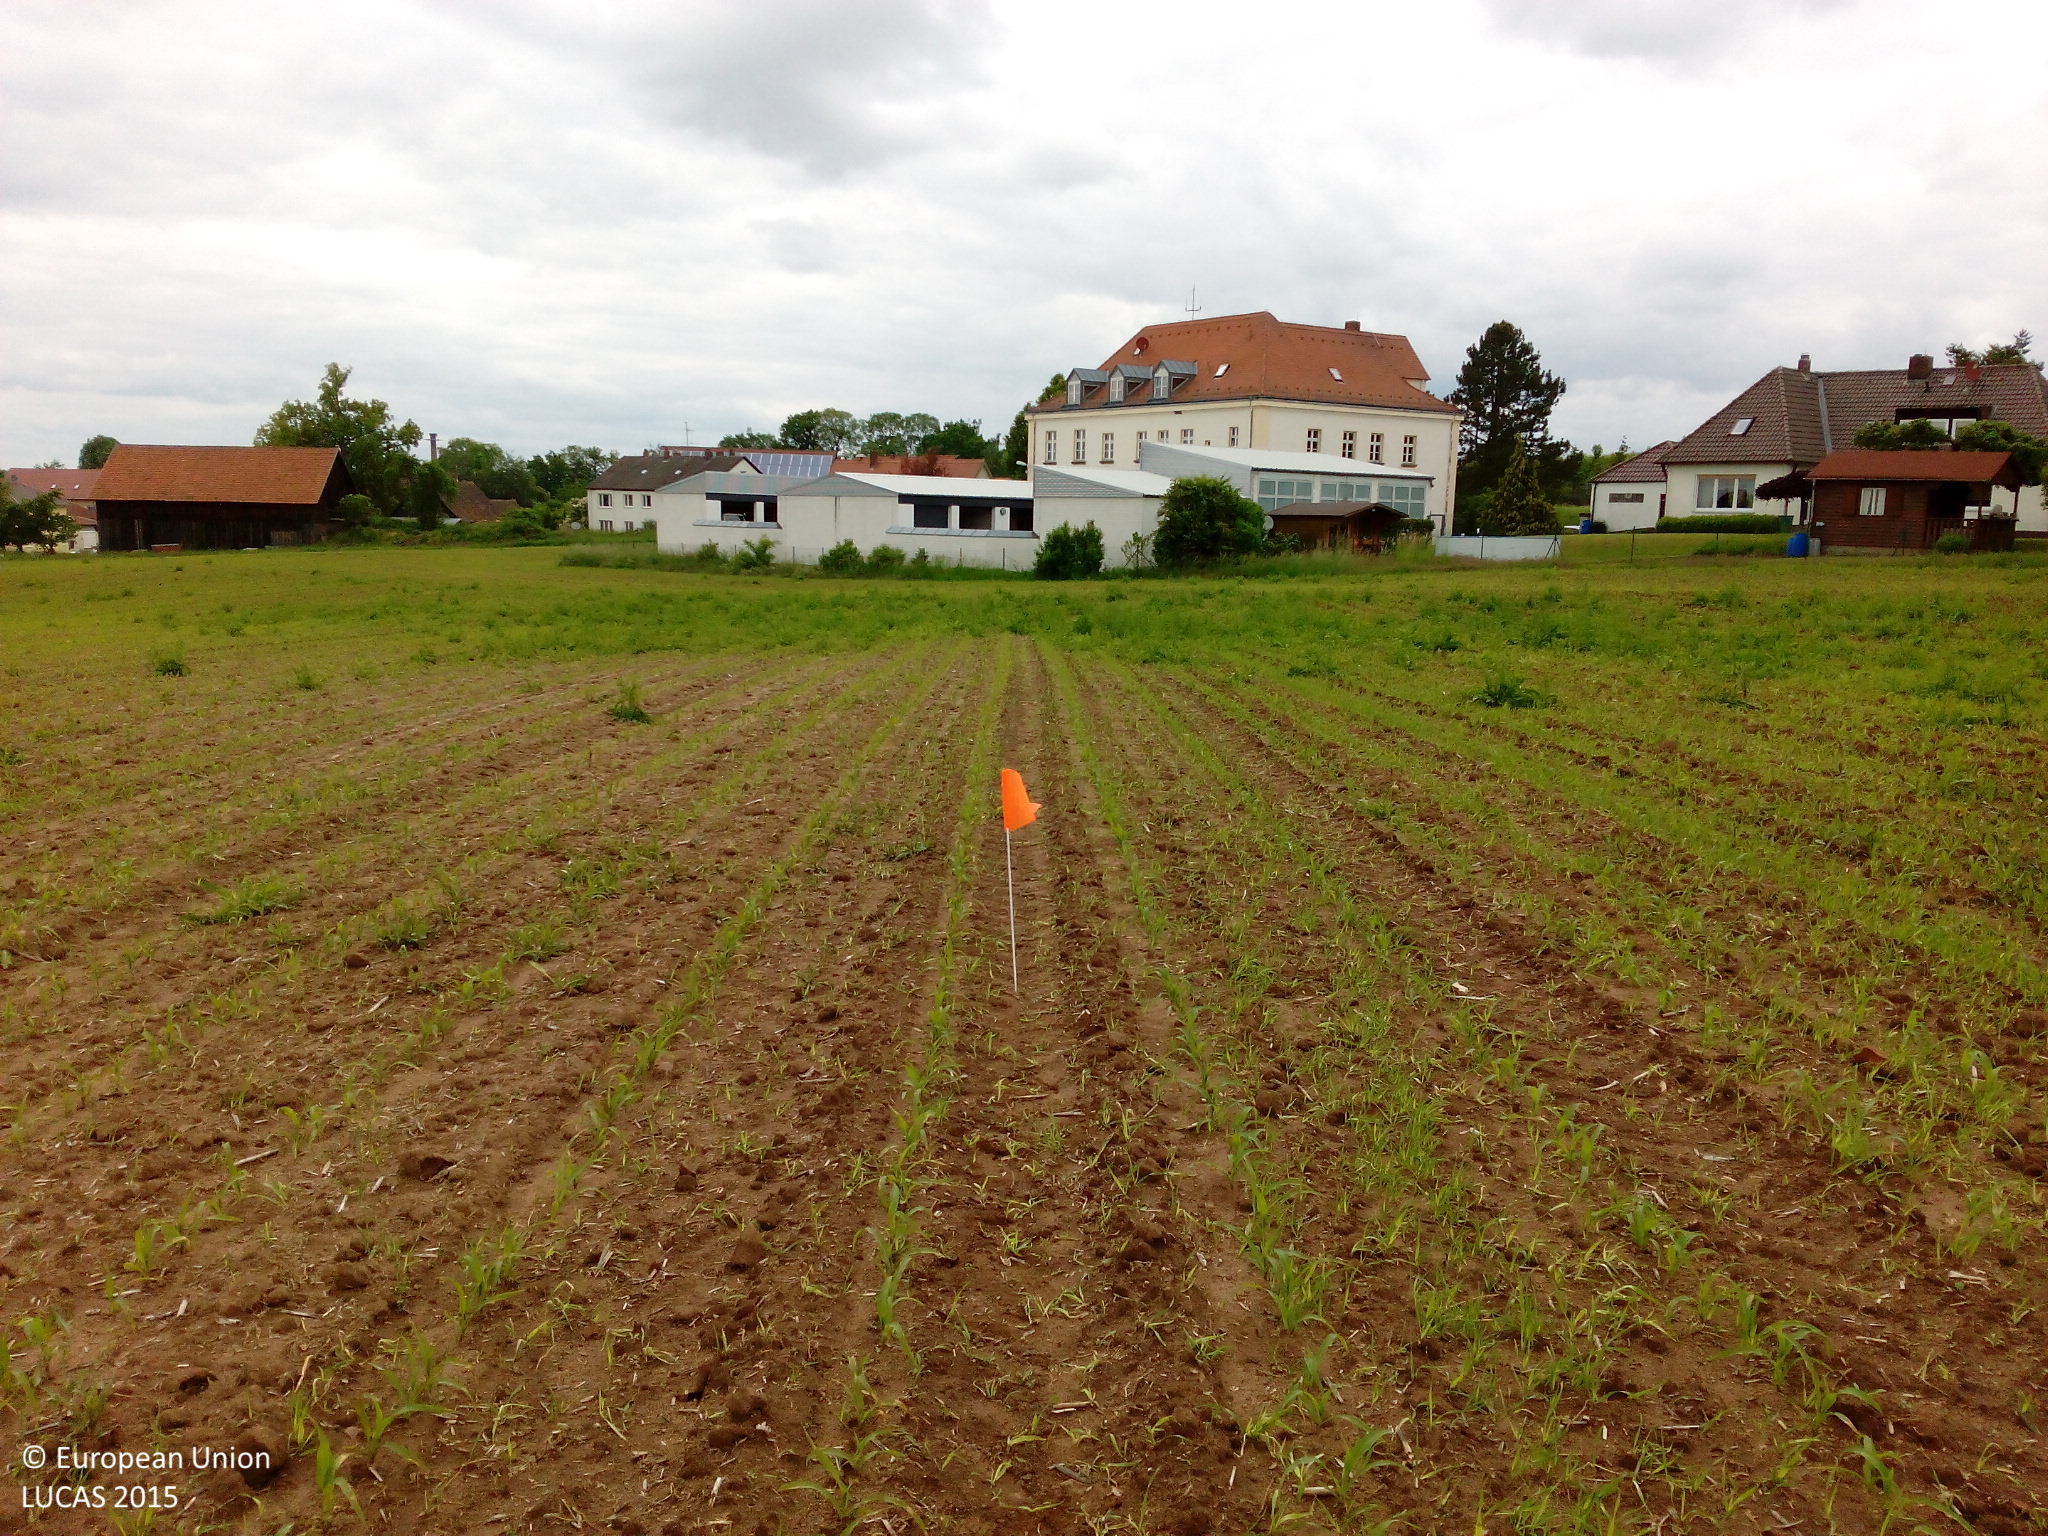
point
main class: Cropland
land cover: Maize
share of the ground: < 10 %
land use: Agriculture (excluding fallow land and kitchen gardens)
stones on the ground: < 10 %
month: May
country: DE
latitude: 49.9212
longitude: 11.6013
